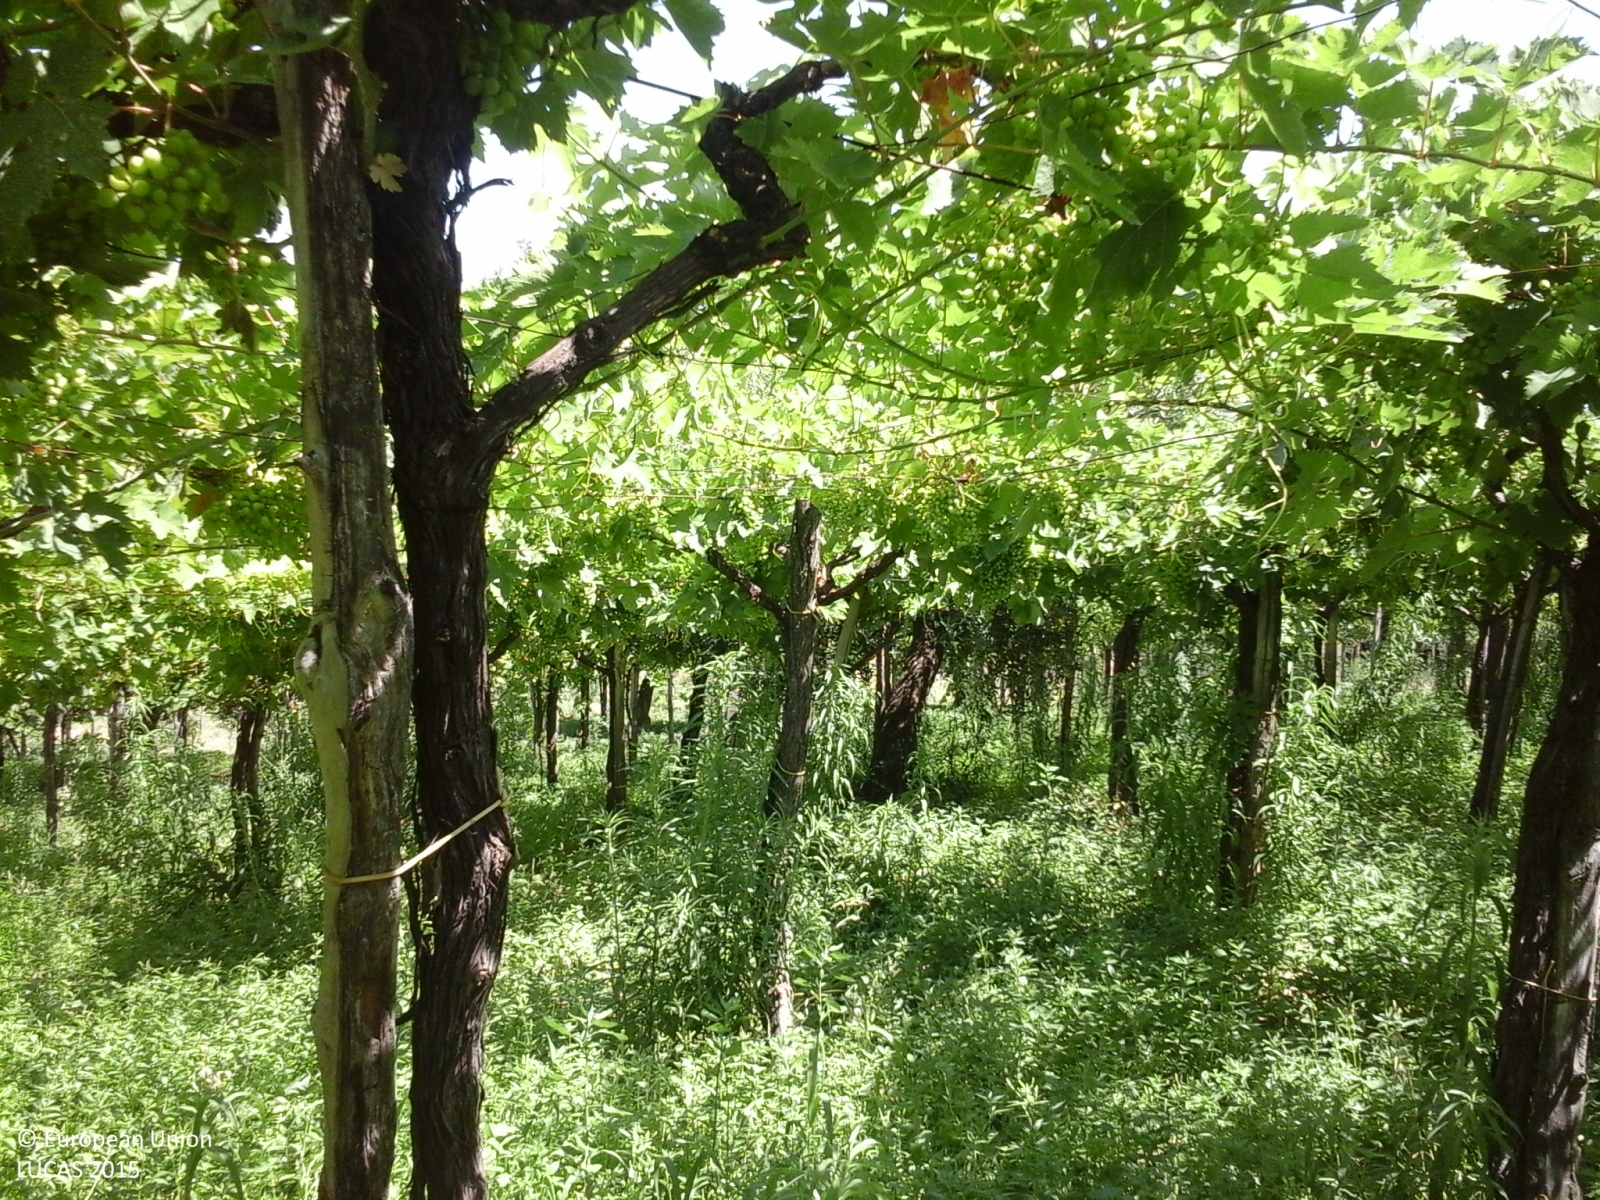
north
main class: Cropland
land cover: Vineyards
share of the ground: 25 - 50 %
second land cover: Spontaneously vegetated surfaces
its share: 25 - 50 %
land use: Agriculture (excluding fallow land and kitchen gardens)
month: July
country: IT
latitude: 42.2907
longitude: 14.3167
